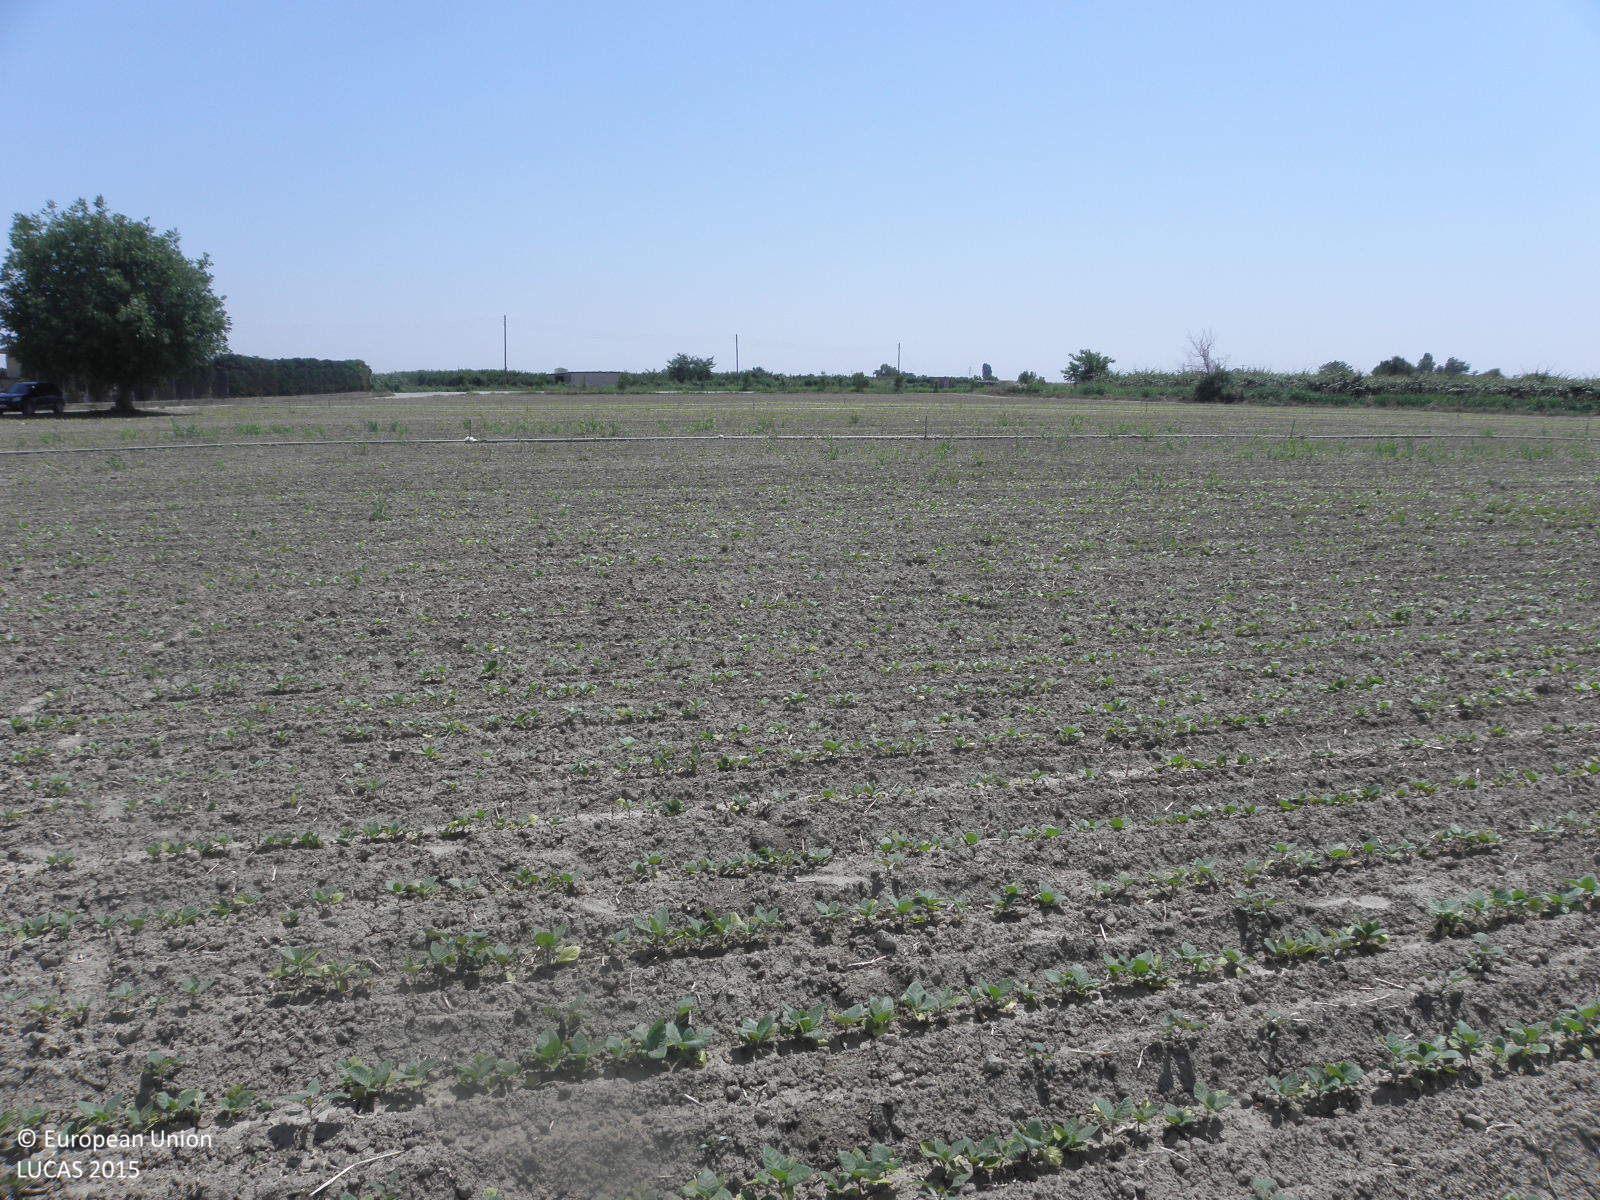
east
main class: Cropland
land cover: Tobacco
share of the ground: < 10 %
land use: Agriculture (excluding fallow land and kitchen gardens)
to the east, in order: Tobacco; Paved roads, cycling and walking lanes; Tobacco; Electric lines; Grass margins; Tracks; Grass margins; Ditches and canals; Grass margins; Tracks; Grass margins; Artificial constructions in urban areas; Apple fruit
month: June
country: GR
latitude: 40.2127
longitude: 22.5111
